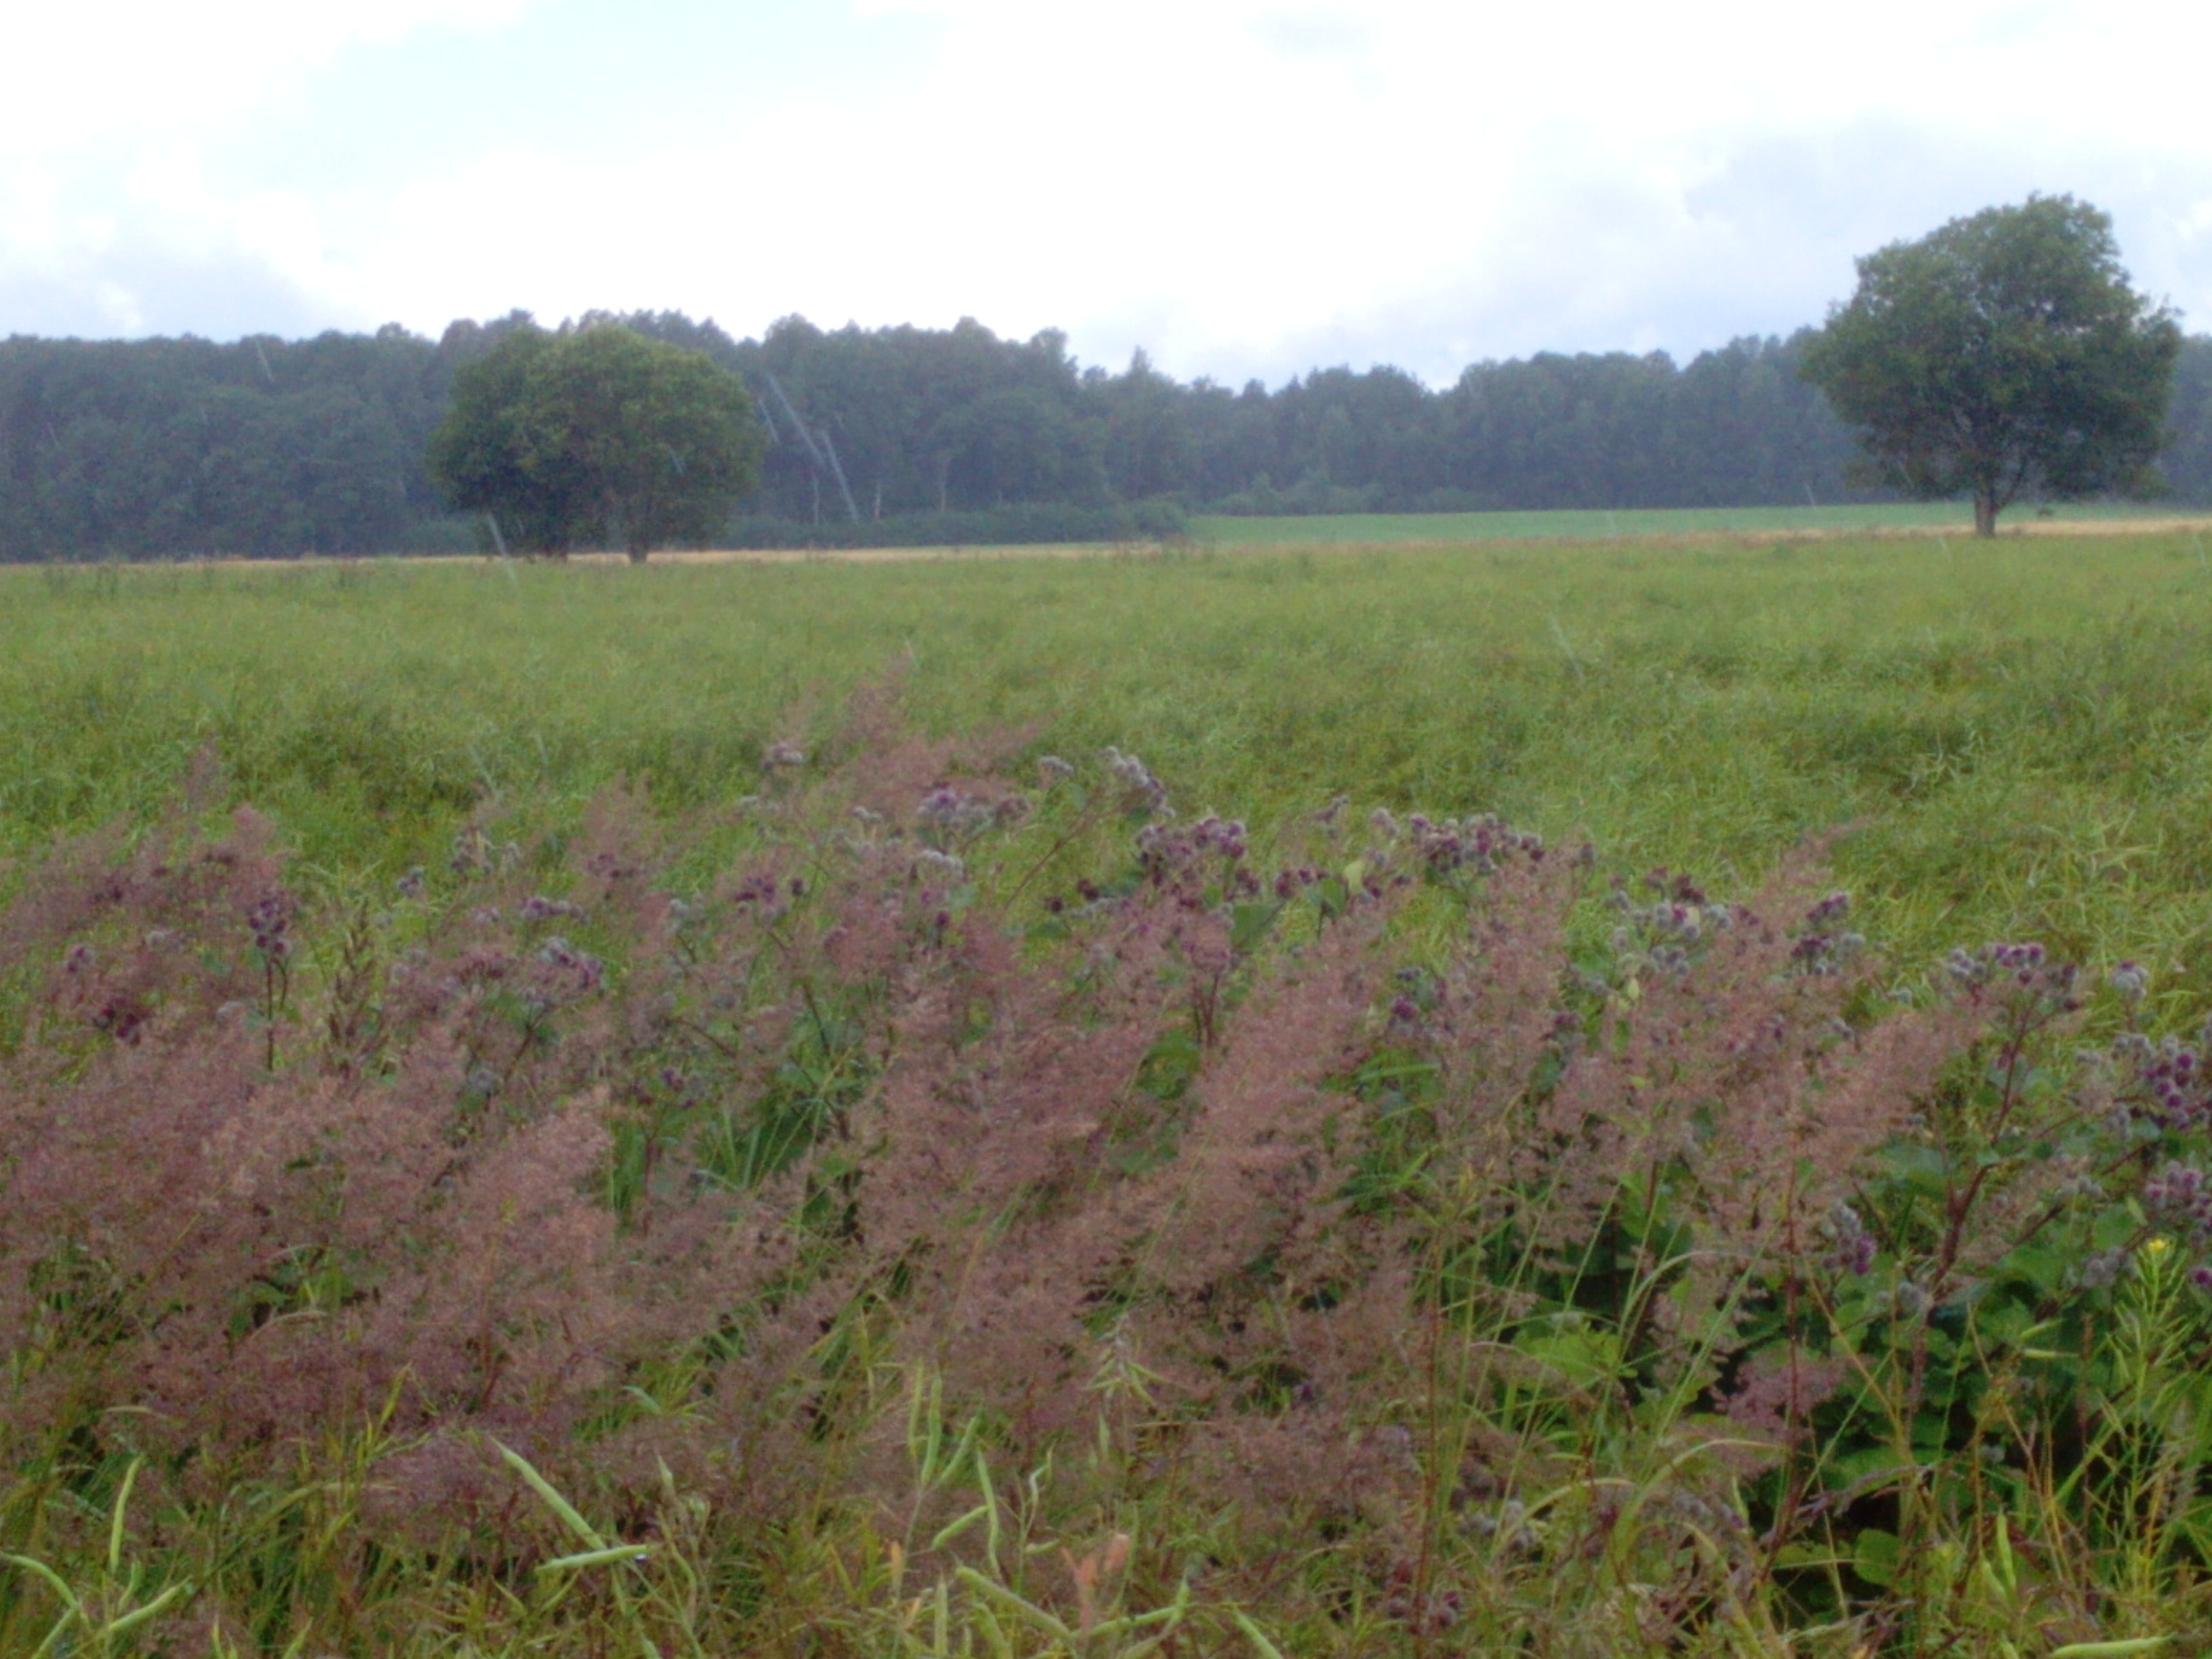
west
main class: Cropland
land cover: Rape and turnip rape
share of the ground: > 75 %
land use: Agriculture (excluding fallow land and kitchen gardens)
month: July
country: LV
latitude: 56.8950
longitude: 22.0156
